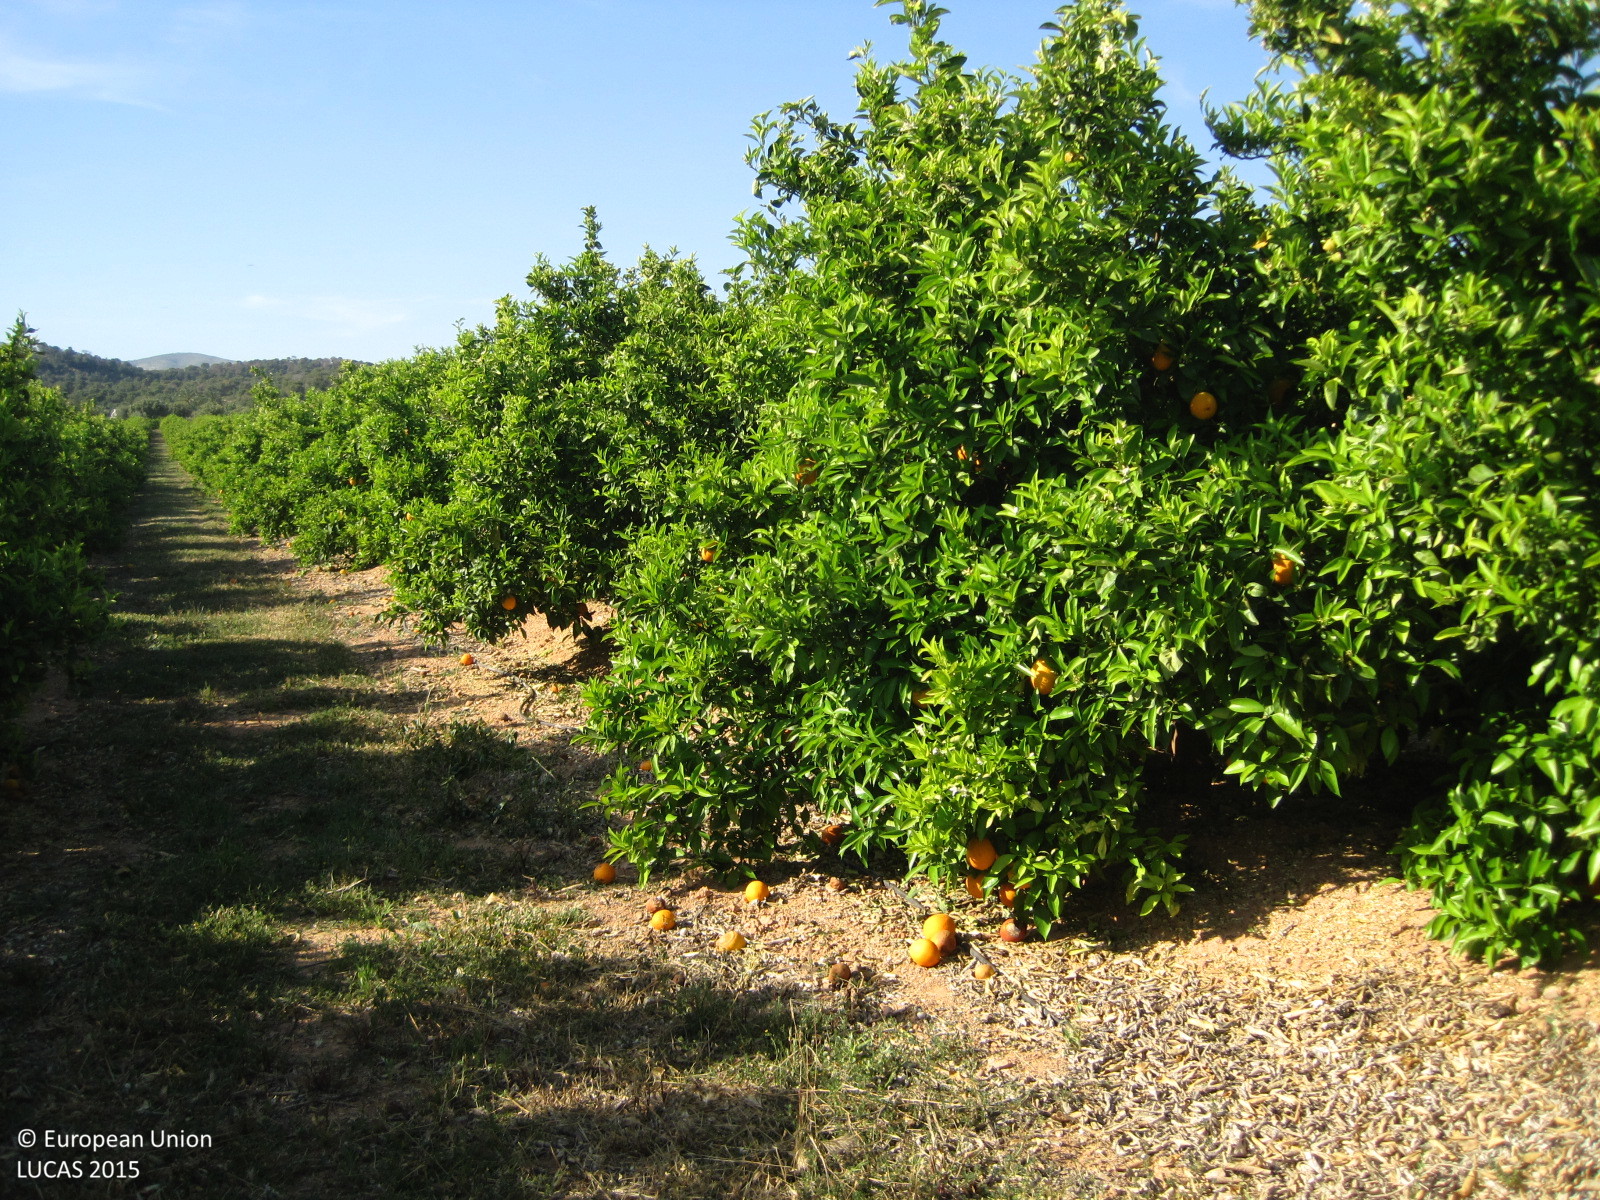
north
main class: Cropland
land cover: Oranges
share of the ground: 25 - 50 %
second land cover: Spontaneously vegetated surfaces
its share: 50 - 75 %
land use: Agriculture (excluding fallow land and kitchen gardens)
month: May
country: ES
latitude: 39.7068
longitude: -0.6265
